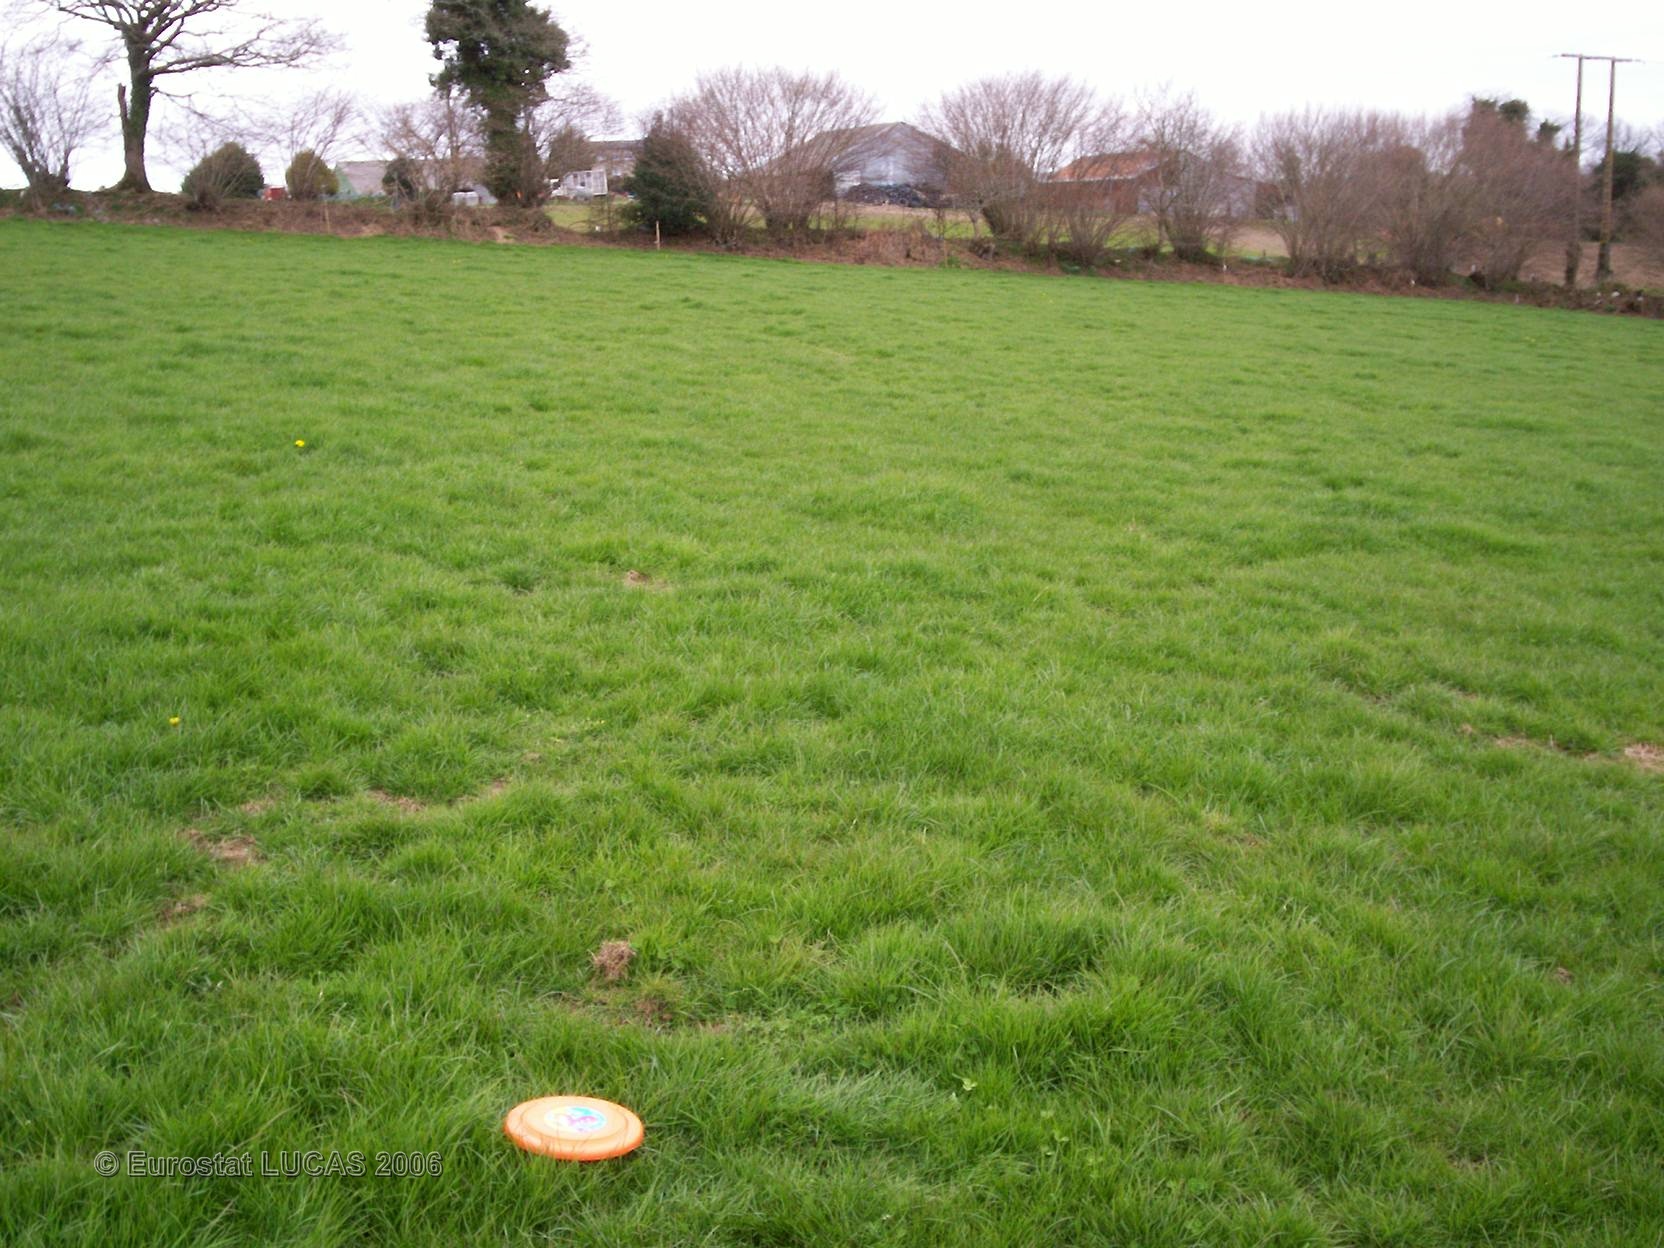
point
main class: Grassland
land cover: Grassland without tree/shrub cover
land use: Agriculture (excluding fallow land and kitchen gardens)
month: April
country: FR
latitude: 48.1935
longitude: -3.6270
